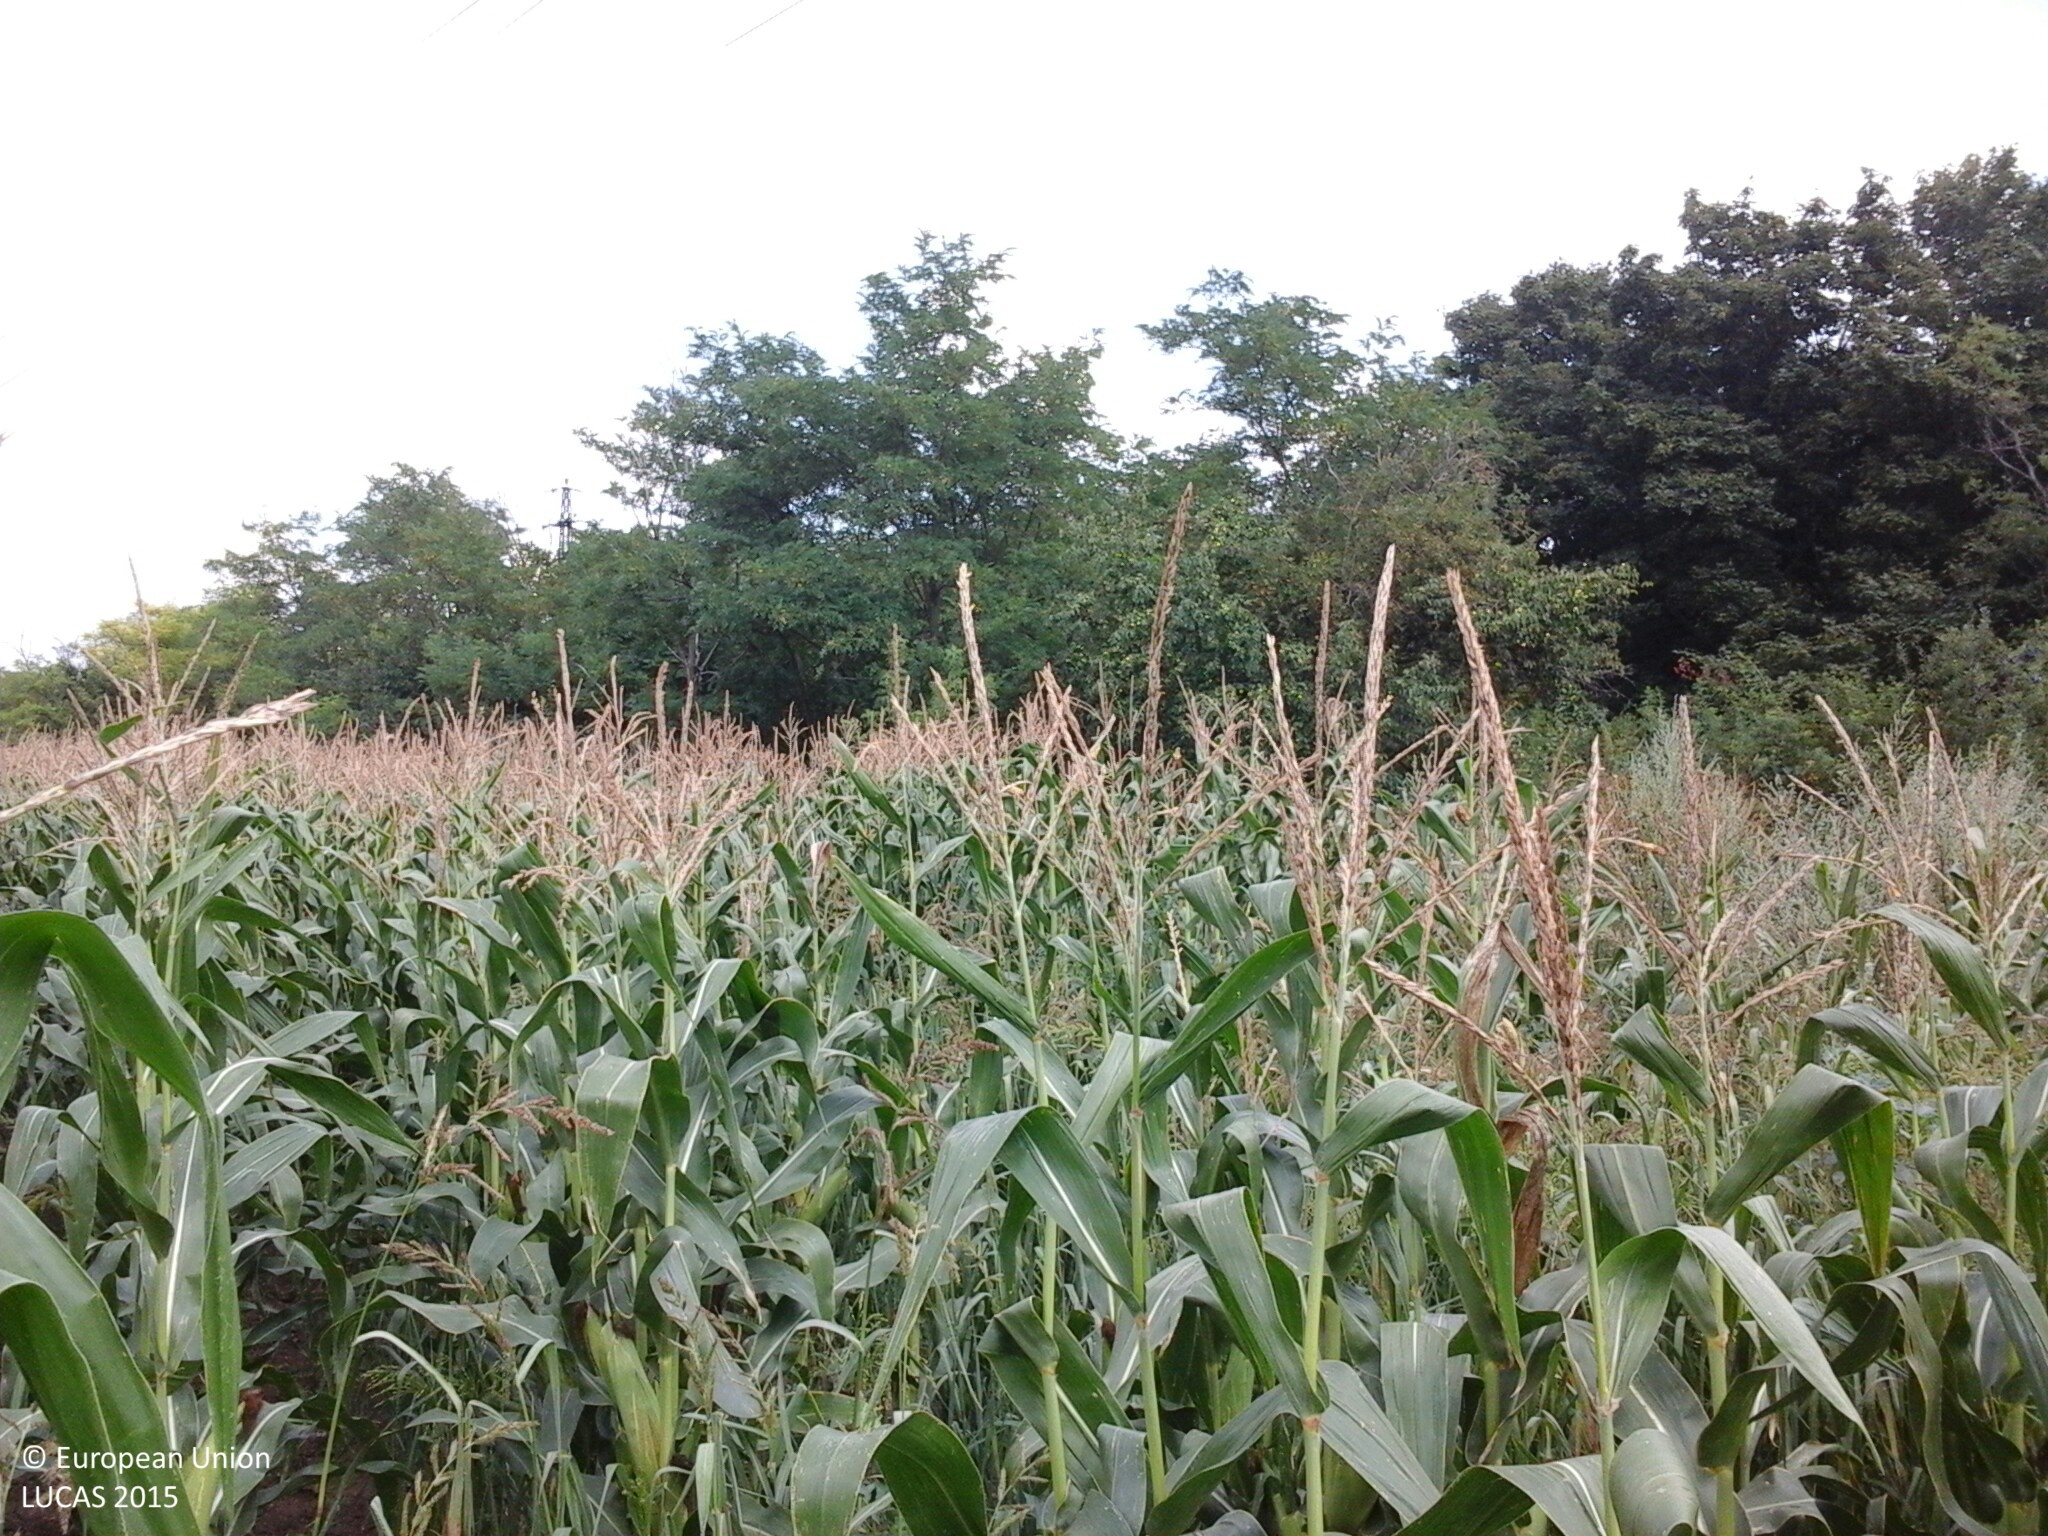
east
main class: Cropland
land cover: Maize
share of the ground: > 75 %
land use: Agriculture (excluding fallow land and kitchen gardens)
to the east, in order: Maize; Electric lines; Maize; Electric lines; Broadleaved woodland; Tracks; Broadleaved woodland
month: August
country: HU
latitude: 47.0347
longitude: 18.1560
